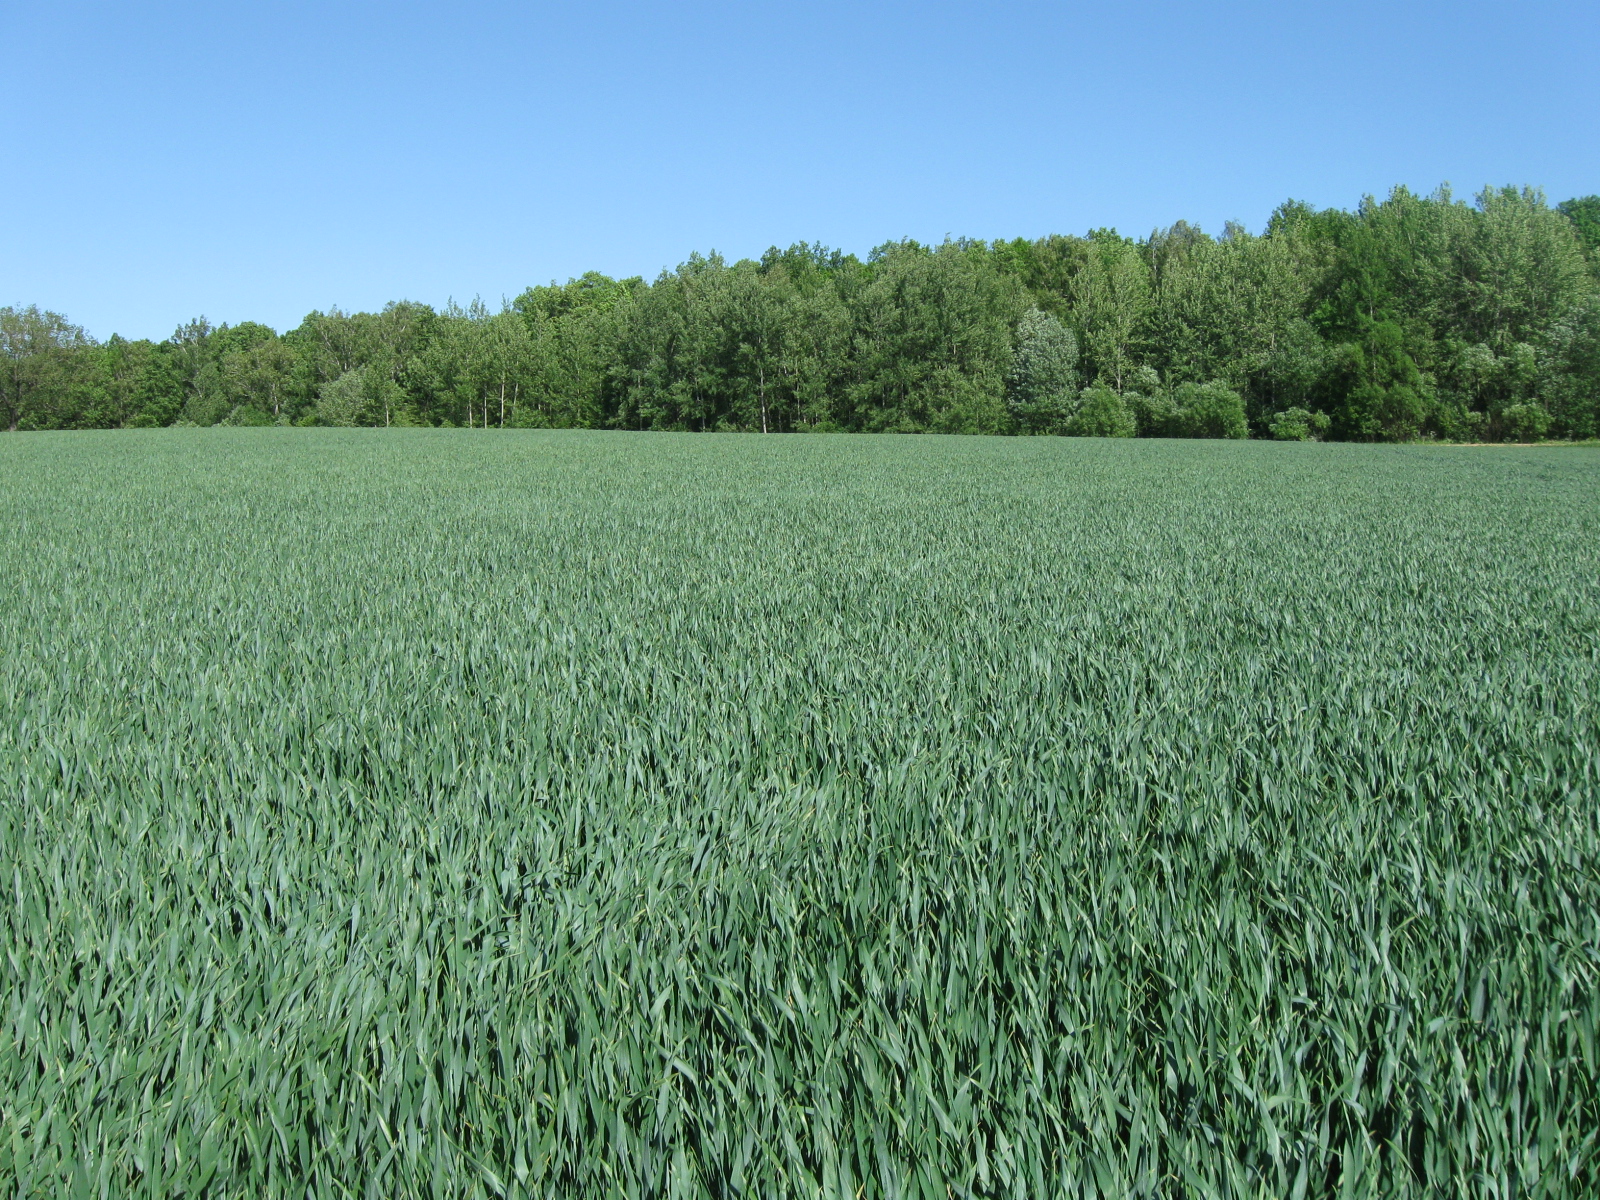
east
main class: Cropland
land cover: Common wheat
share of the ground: > 75 %
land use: Agriculture (excluding fallow land and kitchen gardens)
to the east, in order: Common wheat; Grassland without tree/shrub cover; Paved roads, cycling and walking lanes; Broadleaved woodland
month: June
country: LT
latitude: 54.4225
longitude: 23.7264
